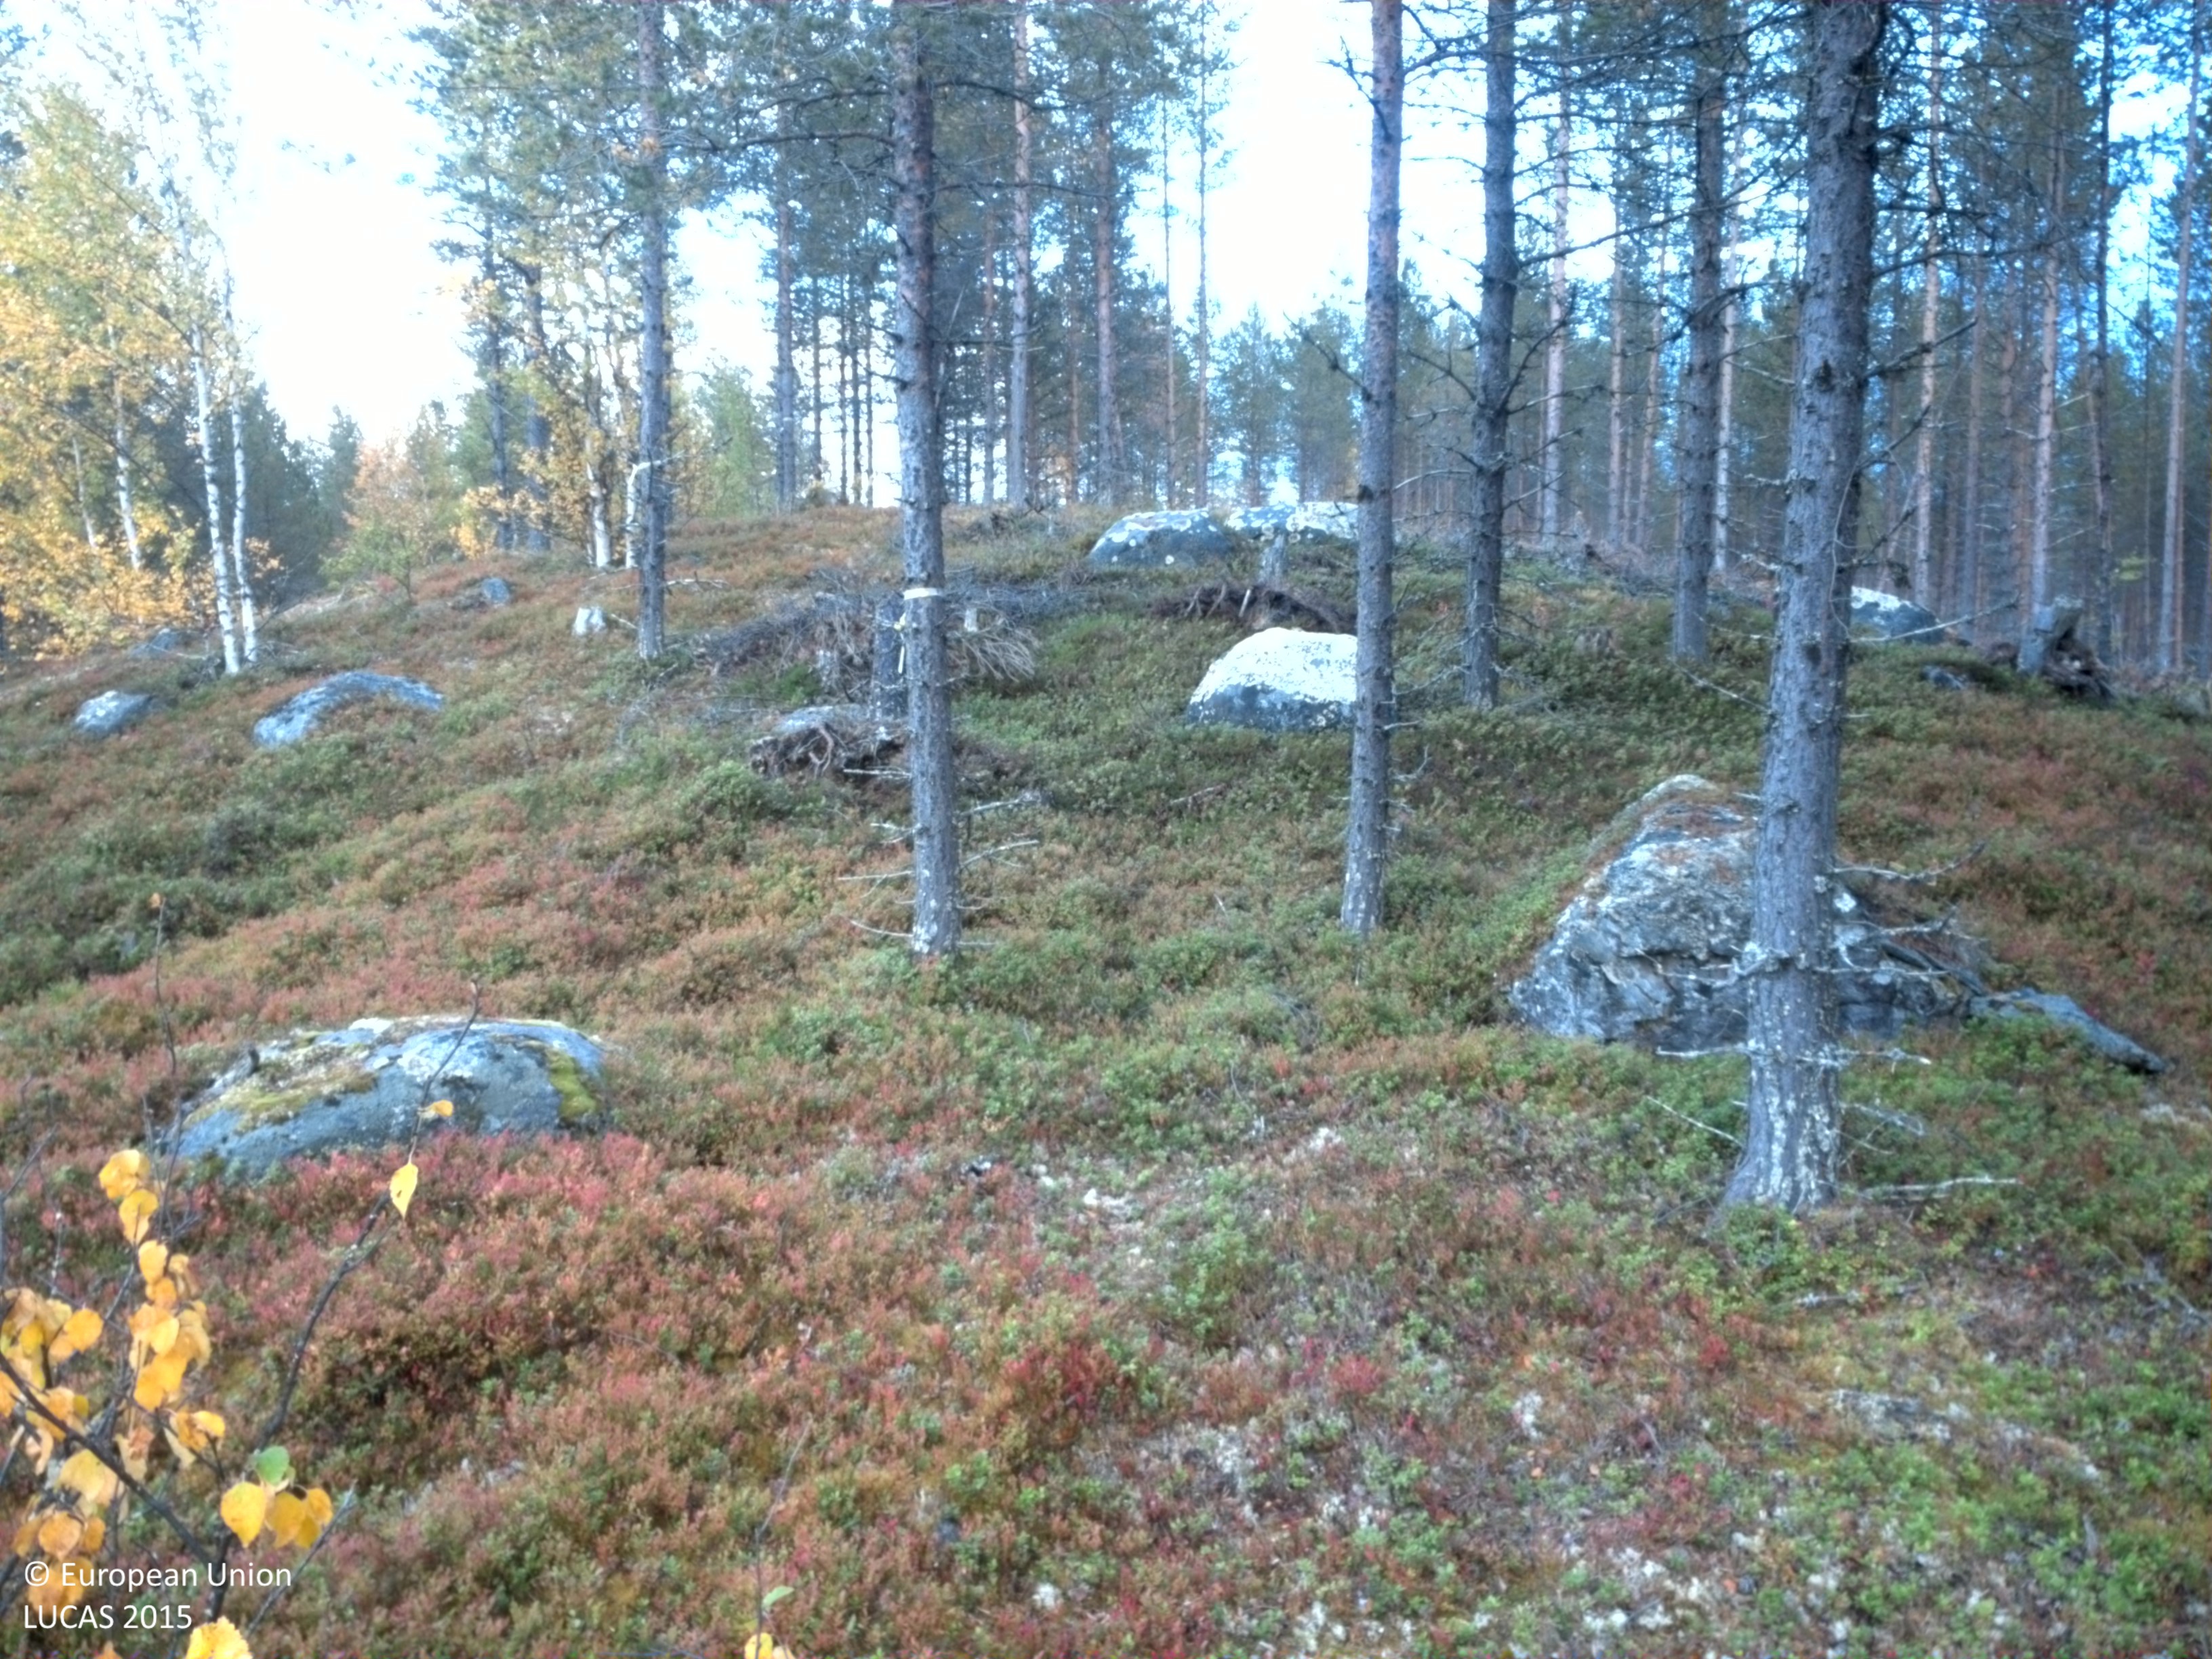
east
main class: Shrubland
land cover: Shrubland with sparse tree cover
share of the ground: 50 - 75 %
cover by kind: shrubs 60 %, lichens and mosses 35 %, broadleaved forest trees 5 %
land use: Forestry
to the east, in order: Shrubland with sparse tree cover; Pine dominated coniferous woodland; Shrubland without tree cover; Grassland with sparse tree/shrub cover; Shrubland with sparse tree cover; Pine dominated mixed woodland; Grassland with sparse tree/shrub cover
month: September
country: SE
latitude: 65.1872
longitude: 16.5624
